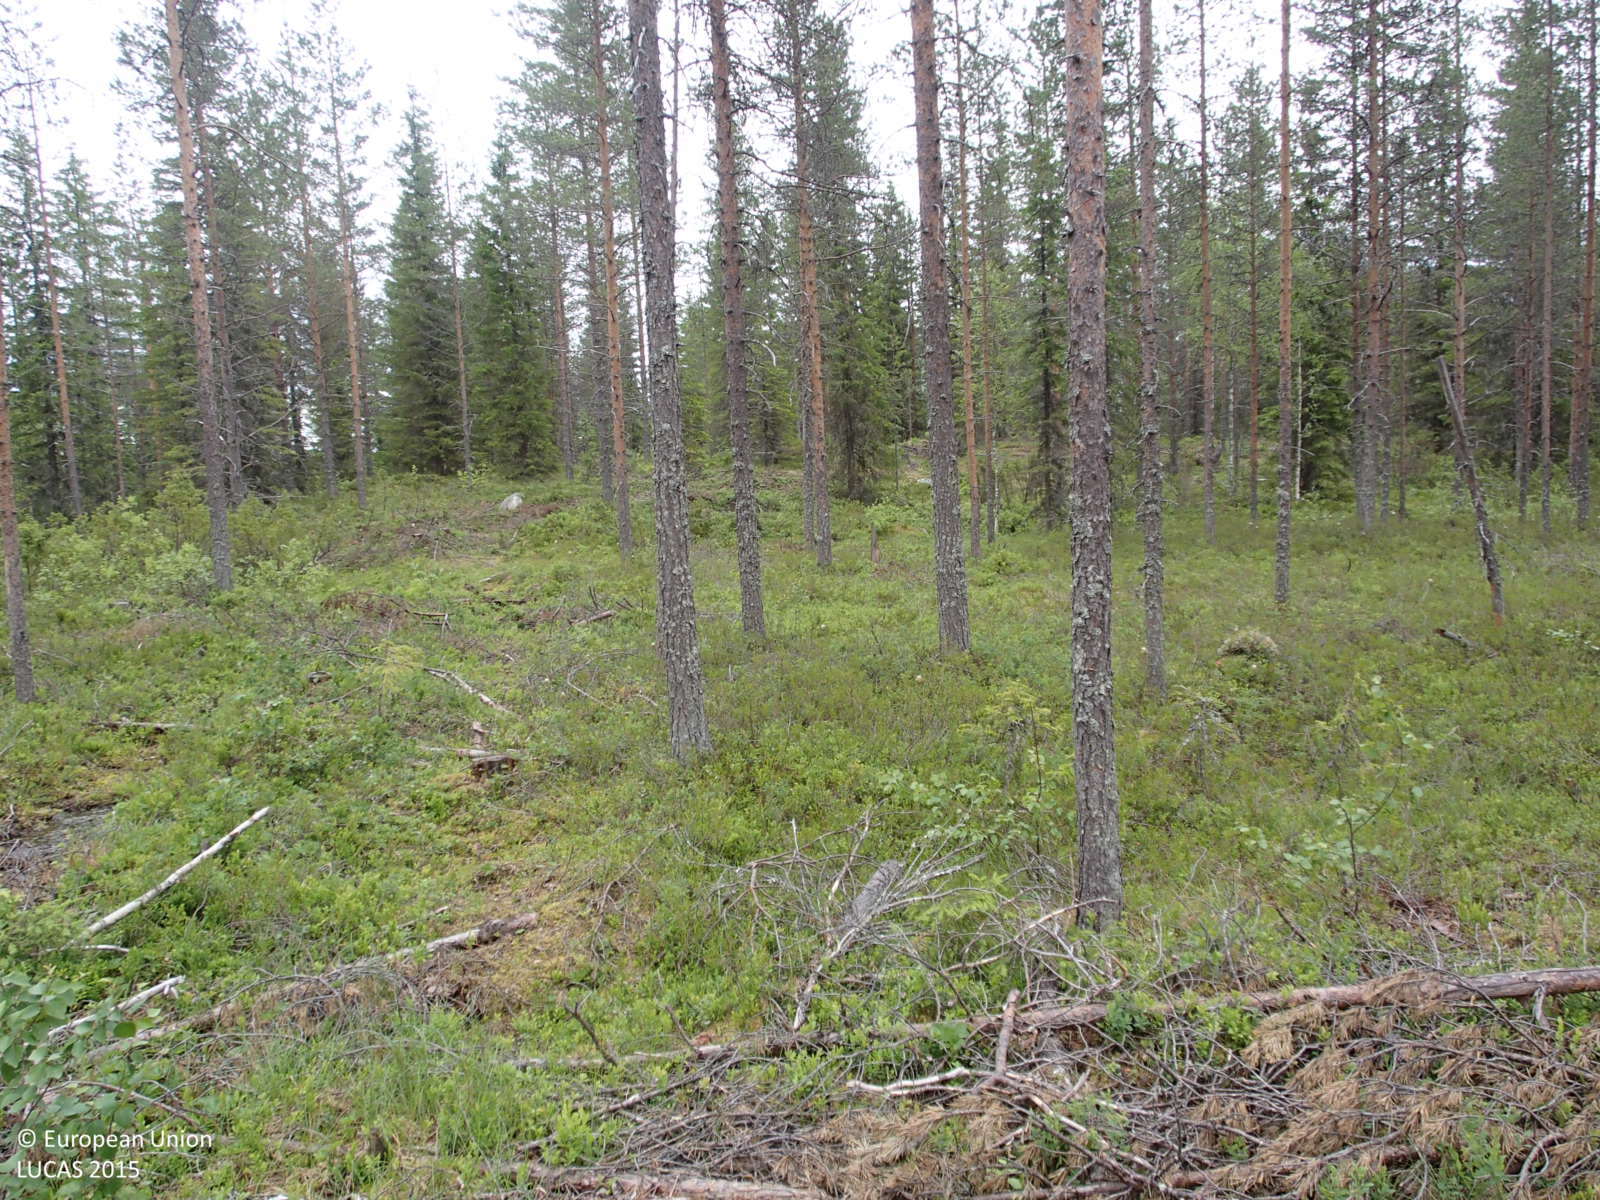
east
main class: Woodland
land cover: Pine dominated coniferous woodland
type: boreal forest
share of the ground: 50 - 75 %
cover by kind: coniferous forest trees 50 %, shrubs 35 %, lichens and mosses 10 %, broadleaved forest trees 5 %
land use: Forestry
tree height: > 5 m
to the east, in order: Pine dominated coniferous woodland; Other coniferous woodland; Spruce dominated coniferous woodland; Ditches and canals; Spruce dominated coniferous woodland; Pine dominated coniferous woodland
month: July
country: FI
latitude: 63.9600
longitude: 27.1044
